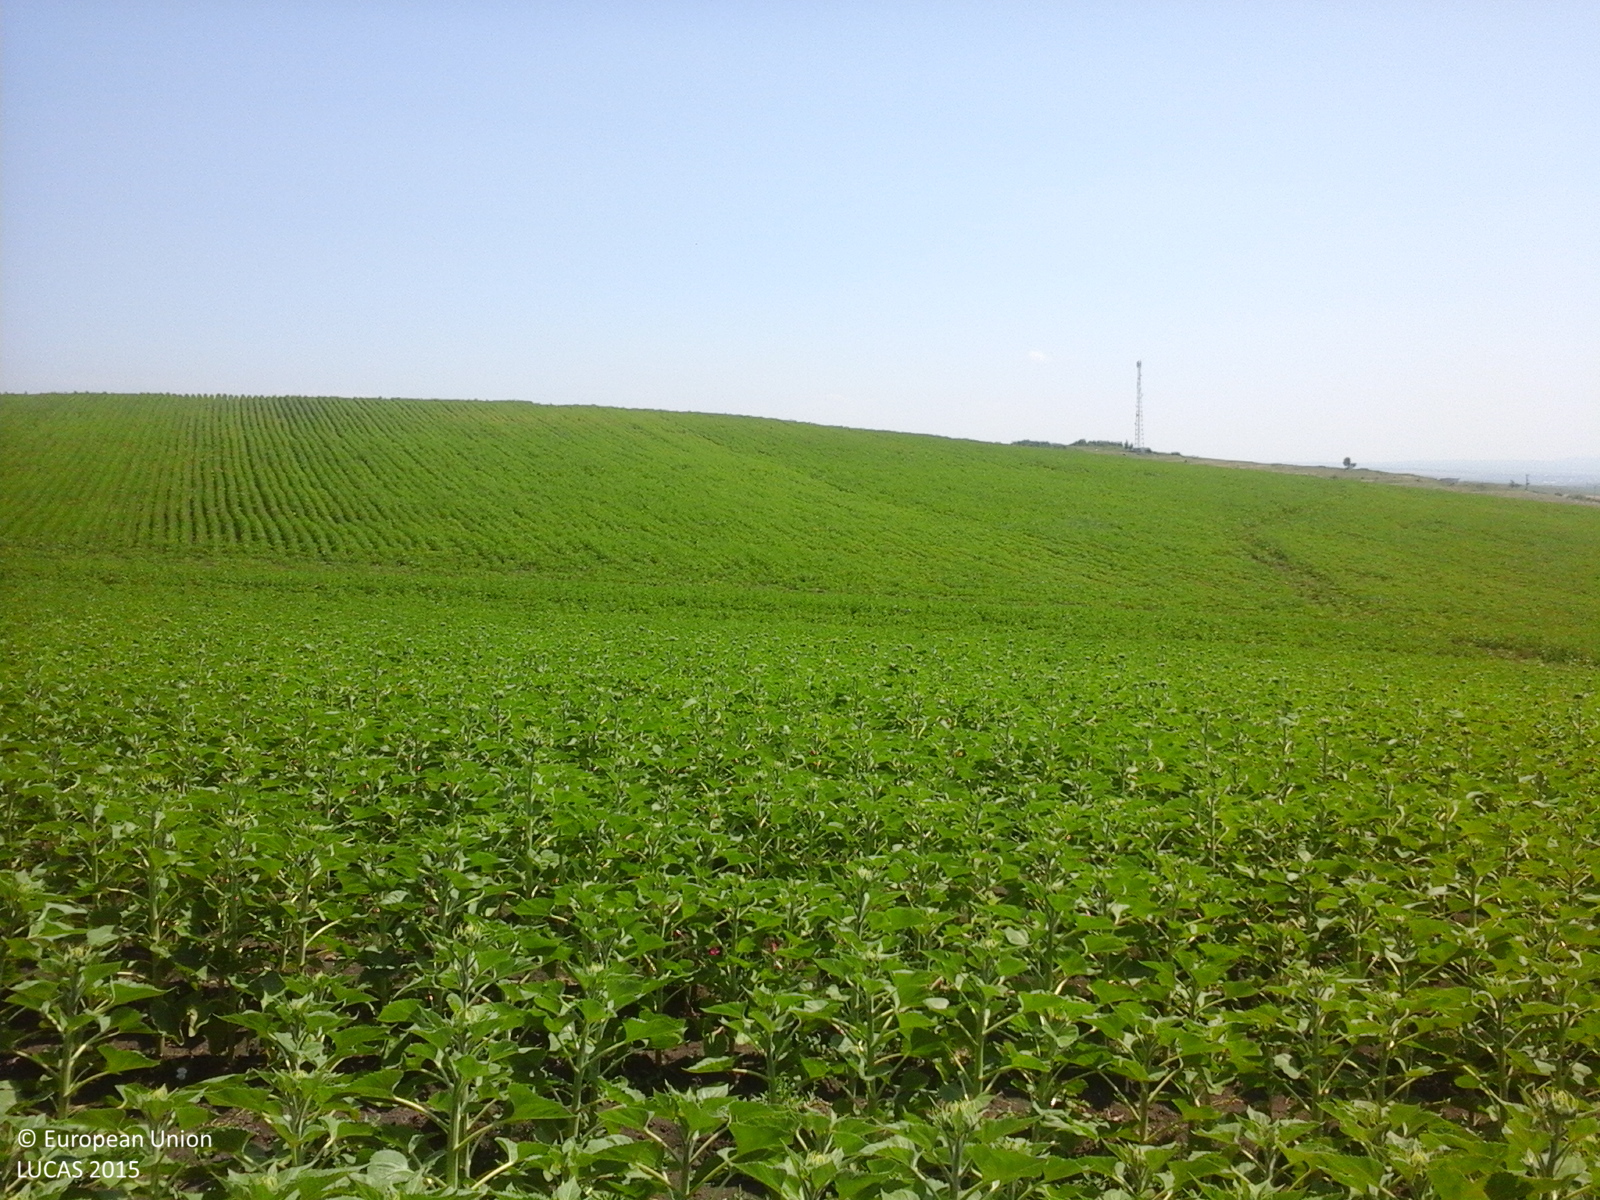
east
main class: Cropland
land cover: Sunflower
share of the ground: > 75 %
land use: Agriculture (excluding fallow land and kitchen gardens)
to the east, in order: Sunflower; Grass margins; Sunflower
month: June
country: RO
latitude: 46.8985
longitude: 27.2898
